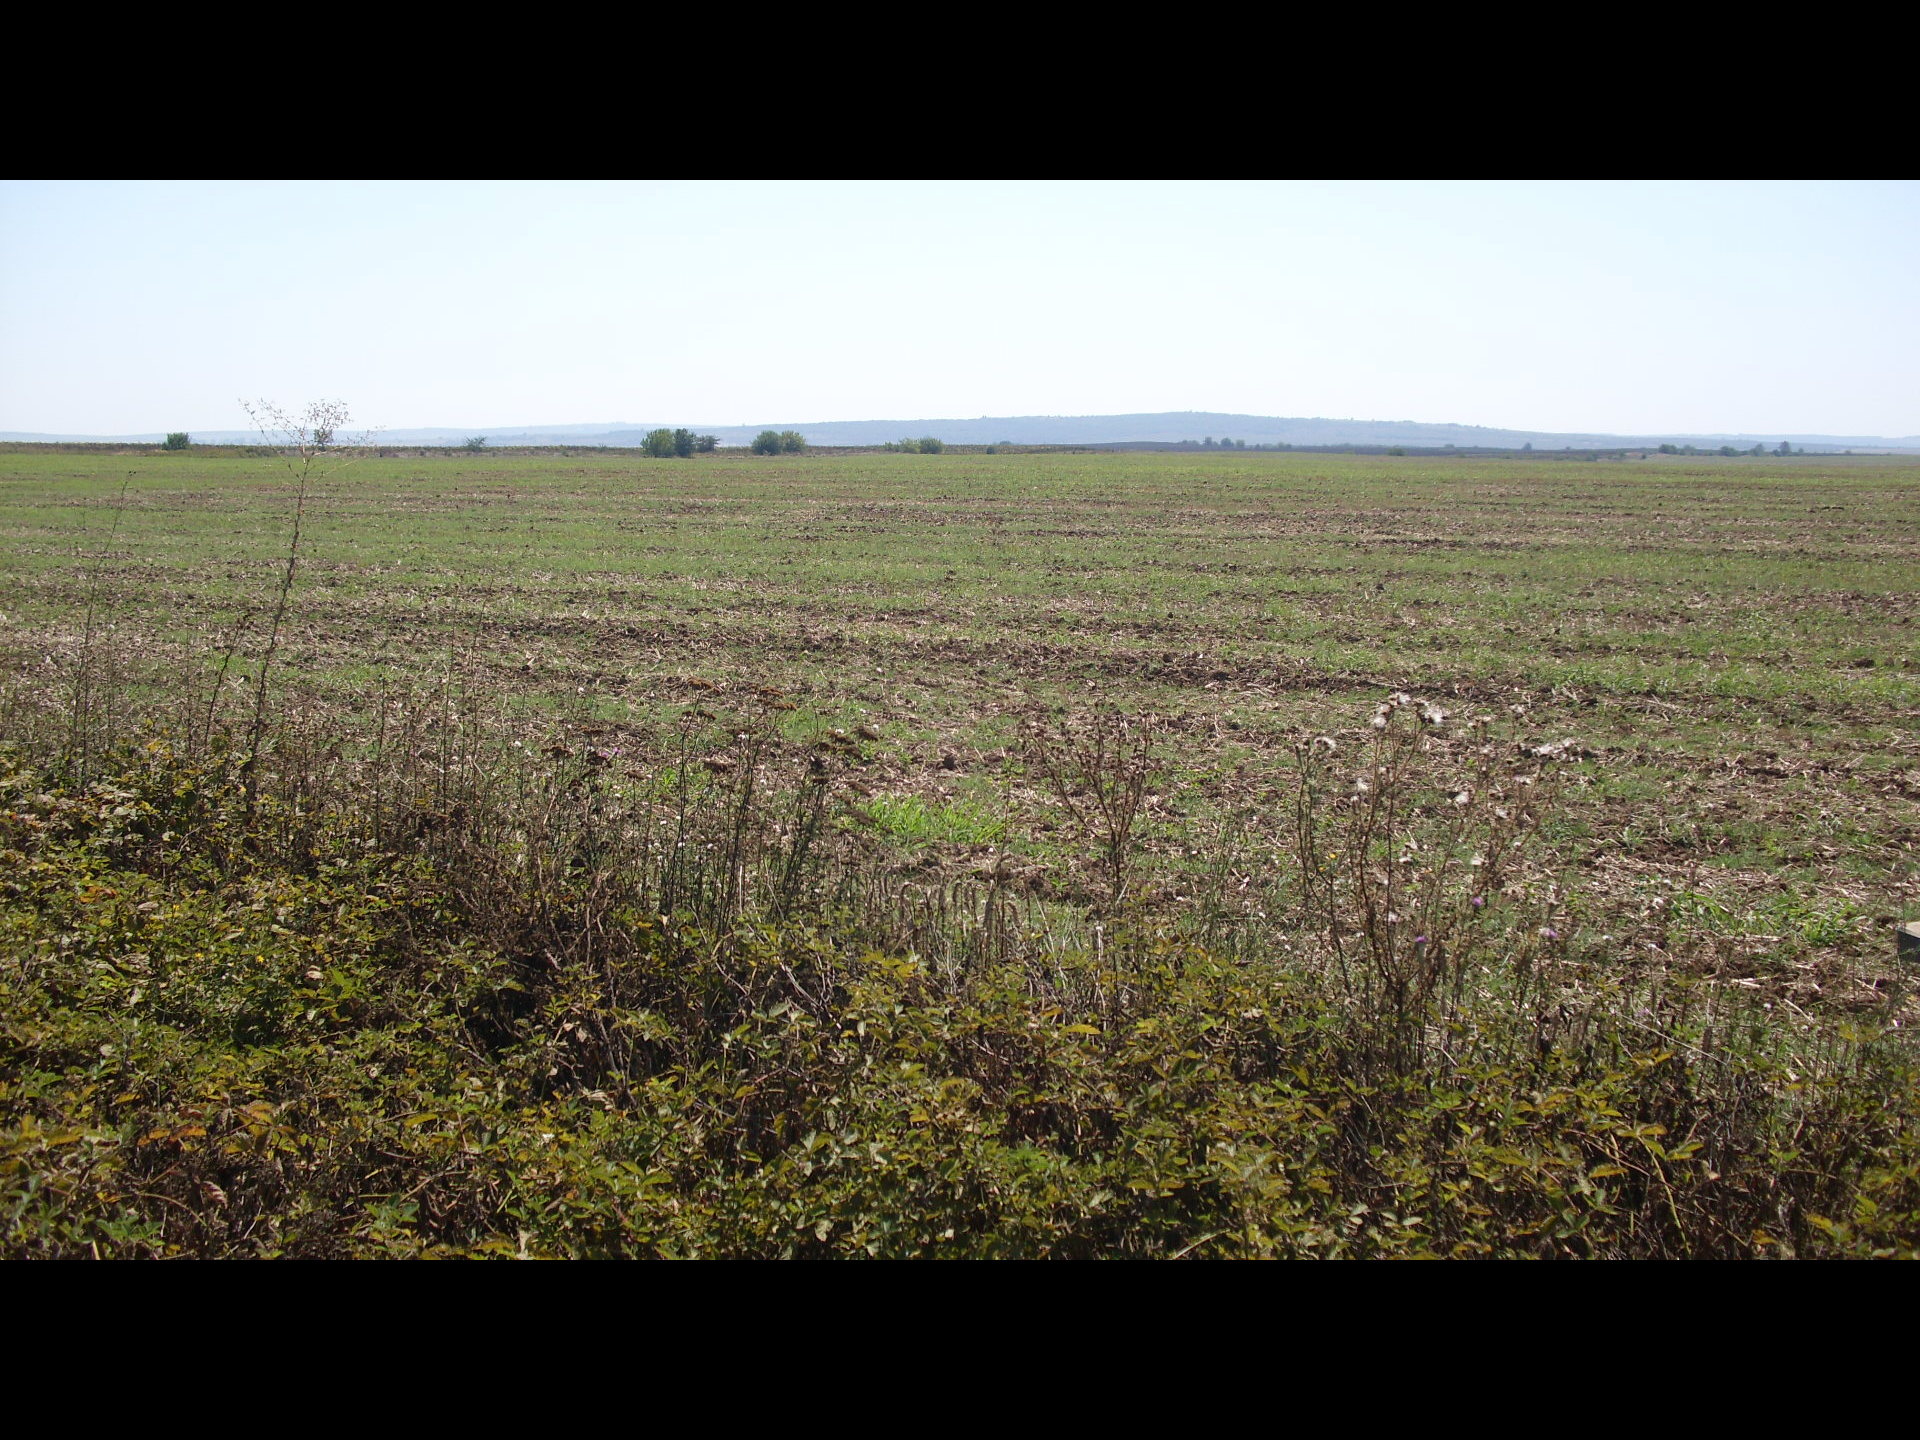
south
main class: Cropland
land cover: Sunflower
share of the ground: > 75 %
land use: Agriculture (excluding fallow land and kitchen gardens)
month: August
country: BG
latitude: 44.1855
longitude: 22.7114
